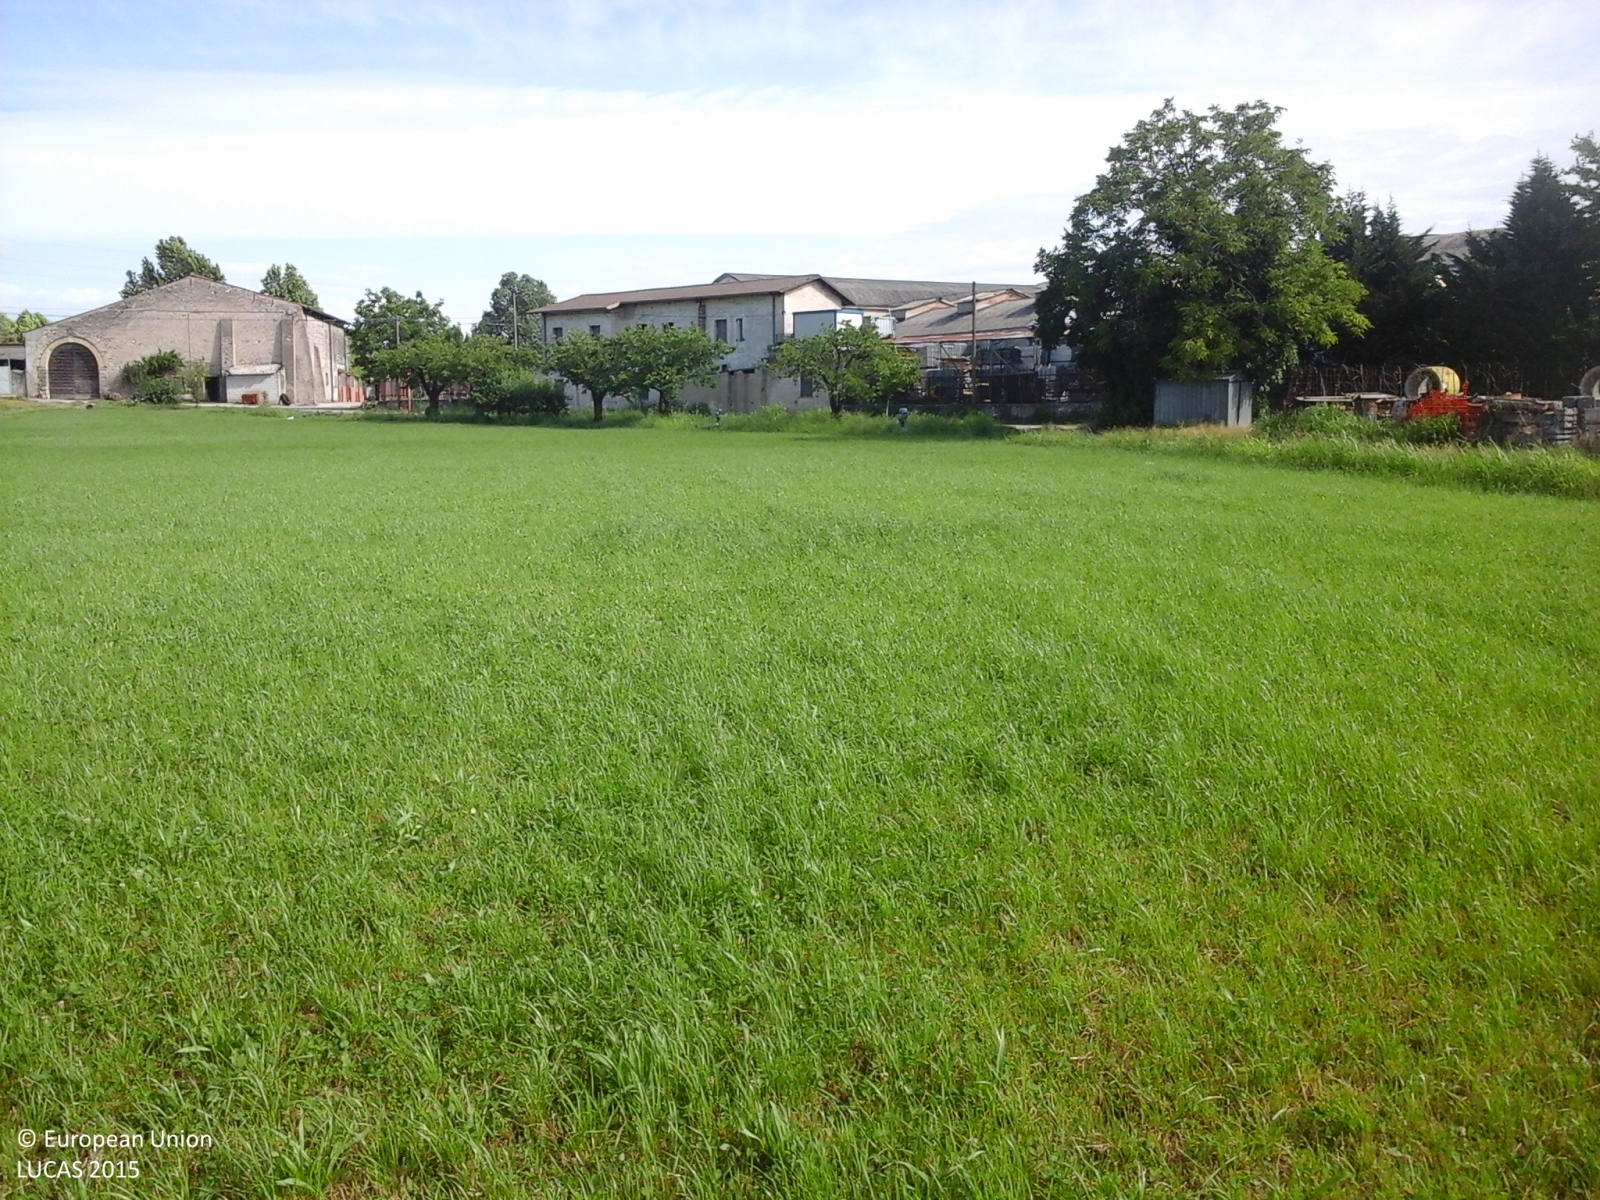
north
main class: Grassland
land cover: Grassland without tree/shrub cover
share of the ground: > 75 %
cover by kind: herbaceous plants 100 %
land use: Agriculture (excluding fallow land and kitchen gardens)
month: June
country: IT
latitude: 45.4085
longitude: 11.1097
